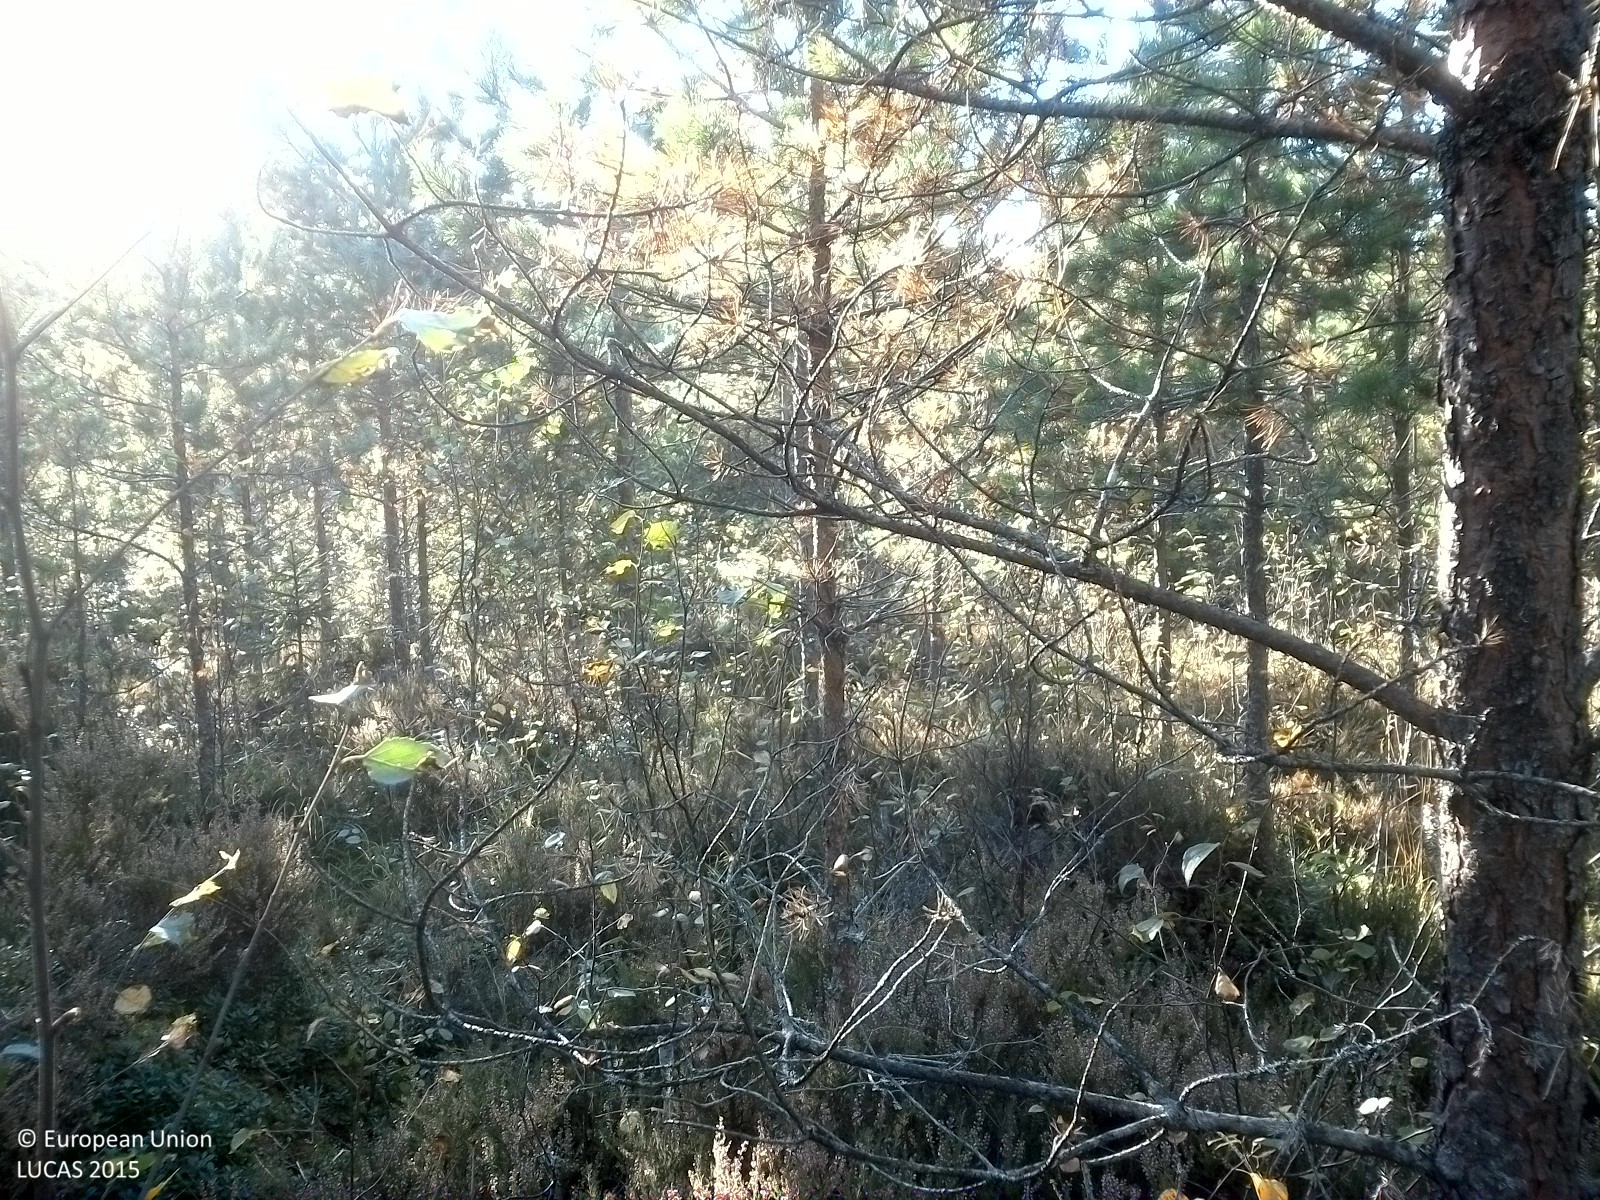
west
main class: Woodland
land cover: Pine dominated coniferous woodland
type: boreal forest
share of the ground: 50 - 75 %
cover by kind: coniferous forest trees 55 %, herbaceous plants 20 %, shrubs 15 %, broadleaved forest trees 5 %, lichens and mosses 5 %
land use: Forestry
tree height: < 5 m
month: September
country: SE
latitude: 58.7904
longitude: 15.5474
